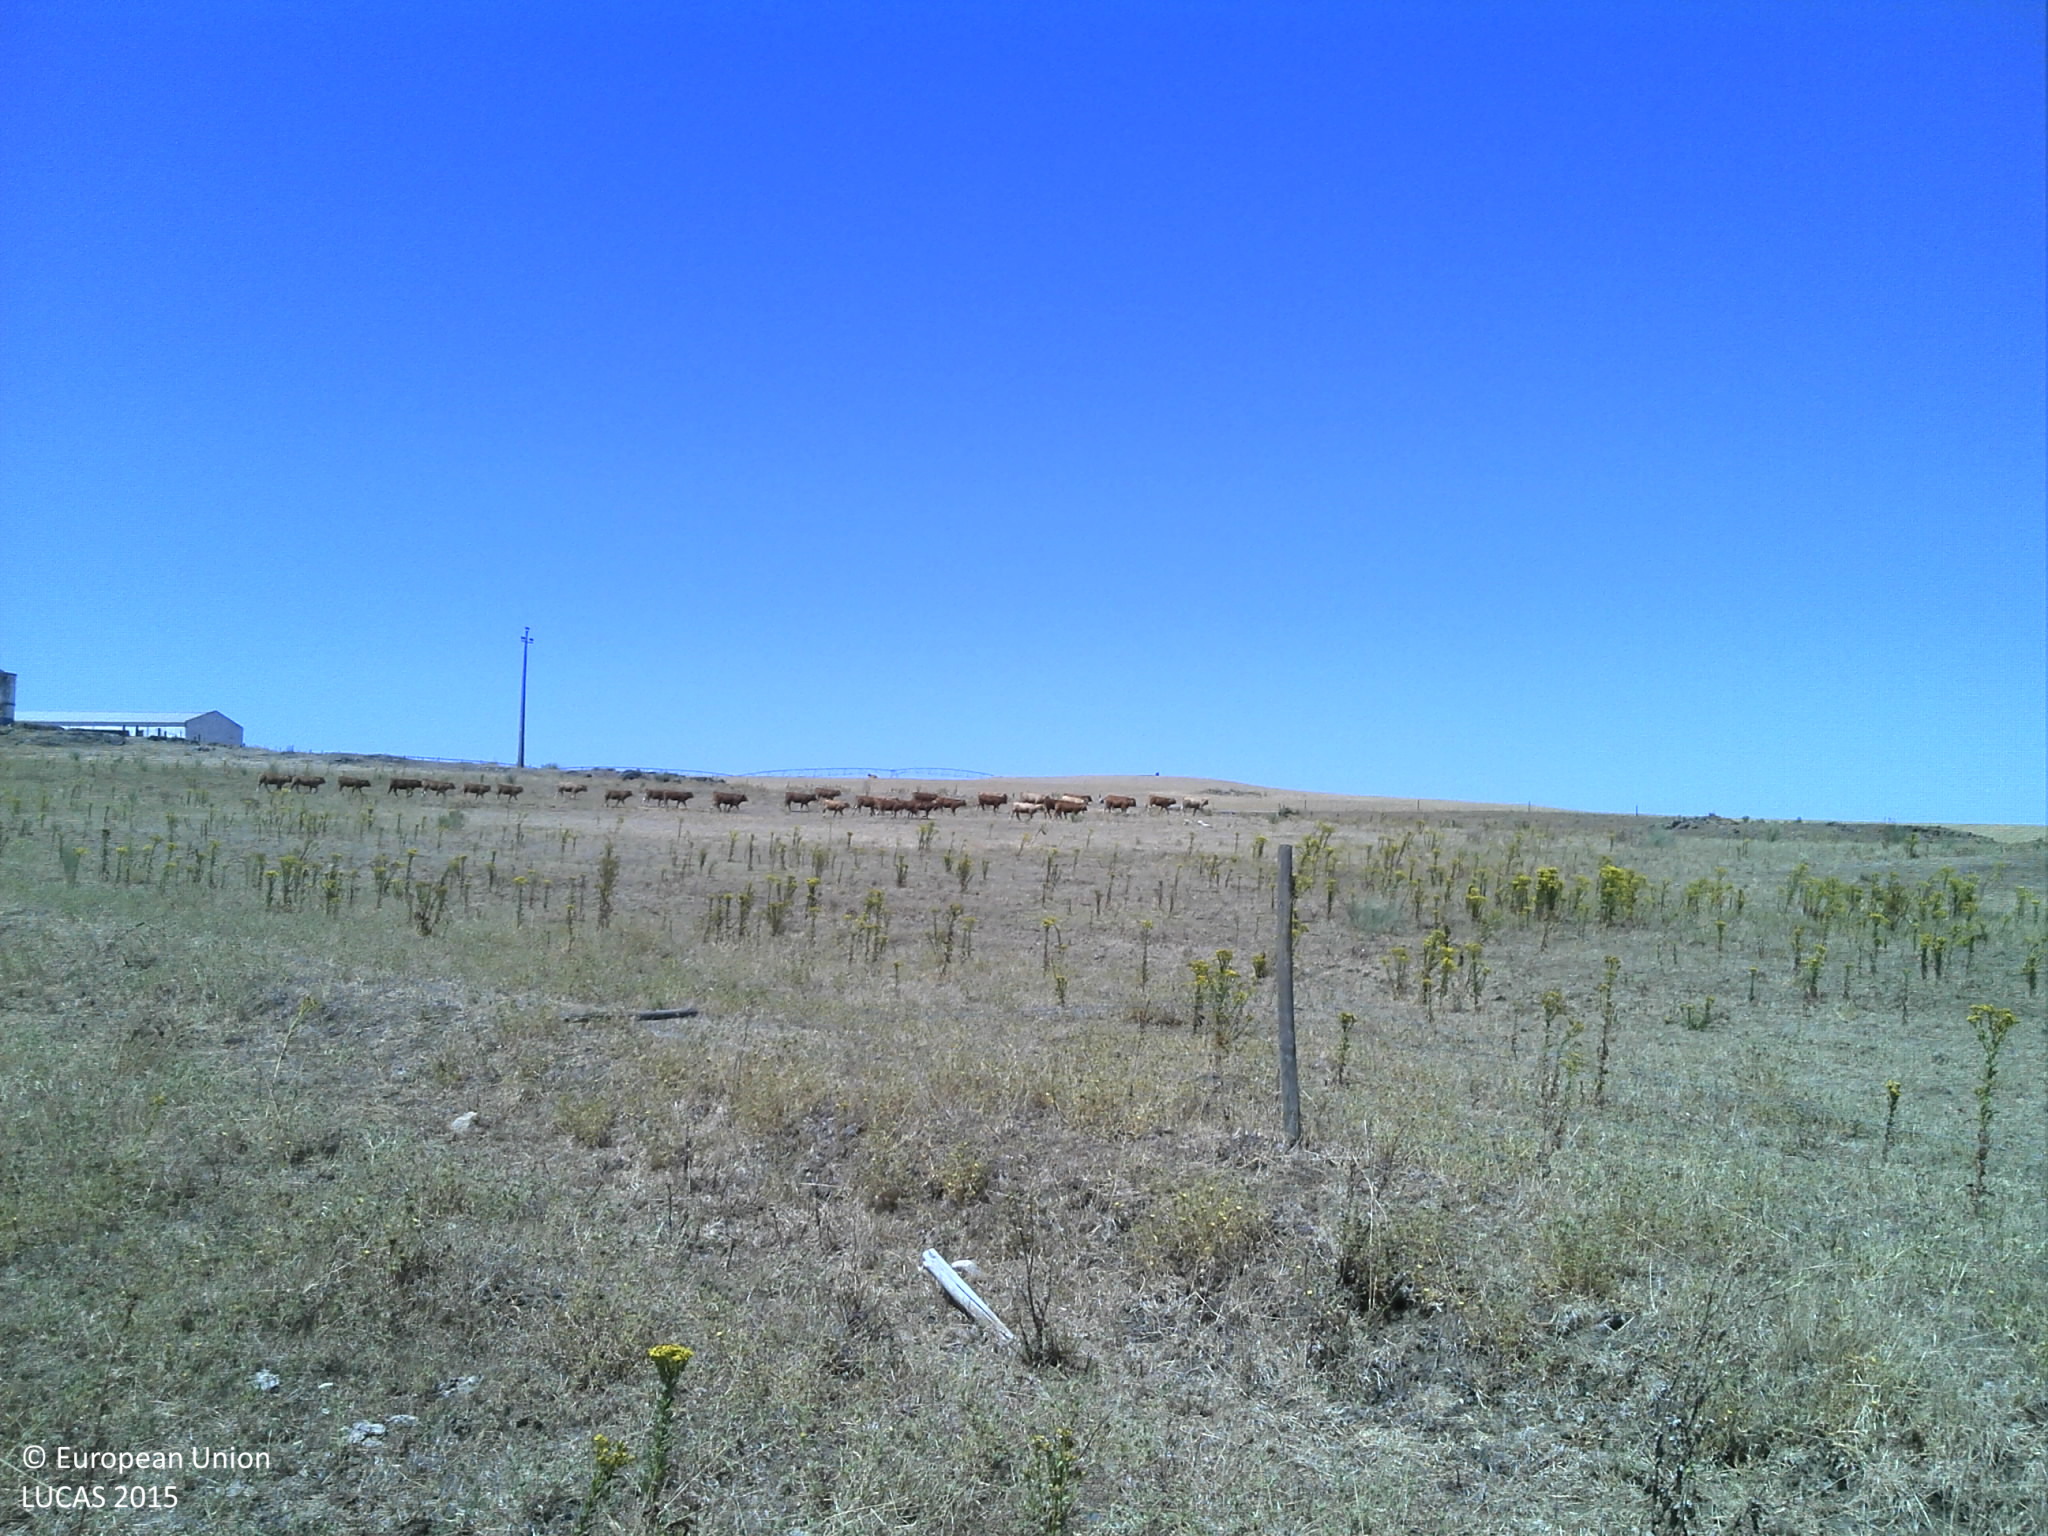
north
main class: Grassland
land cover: Grassland without tree/shrub cover
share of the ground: 25 - 50 %
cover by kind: unconsolidated bare surface 75 %, herbaceous plants 25 %
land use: Agriculture (excluding fallow land and kitchen gardens)
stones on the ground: < 10 %
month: July
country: PT
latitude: 38.9809
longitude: -7.5739
